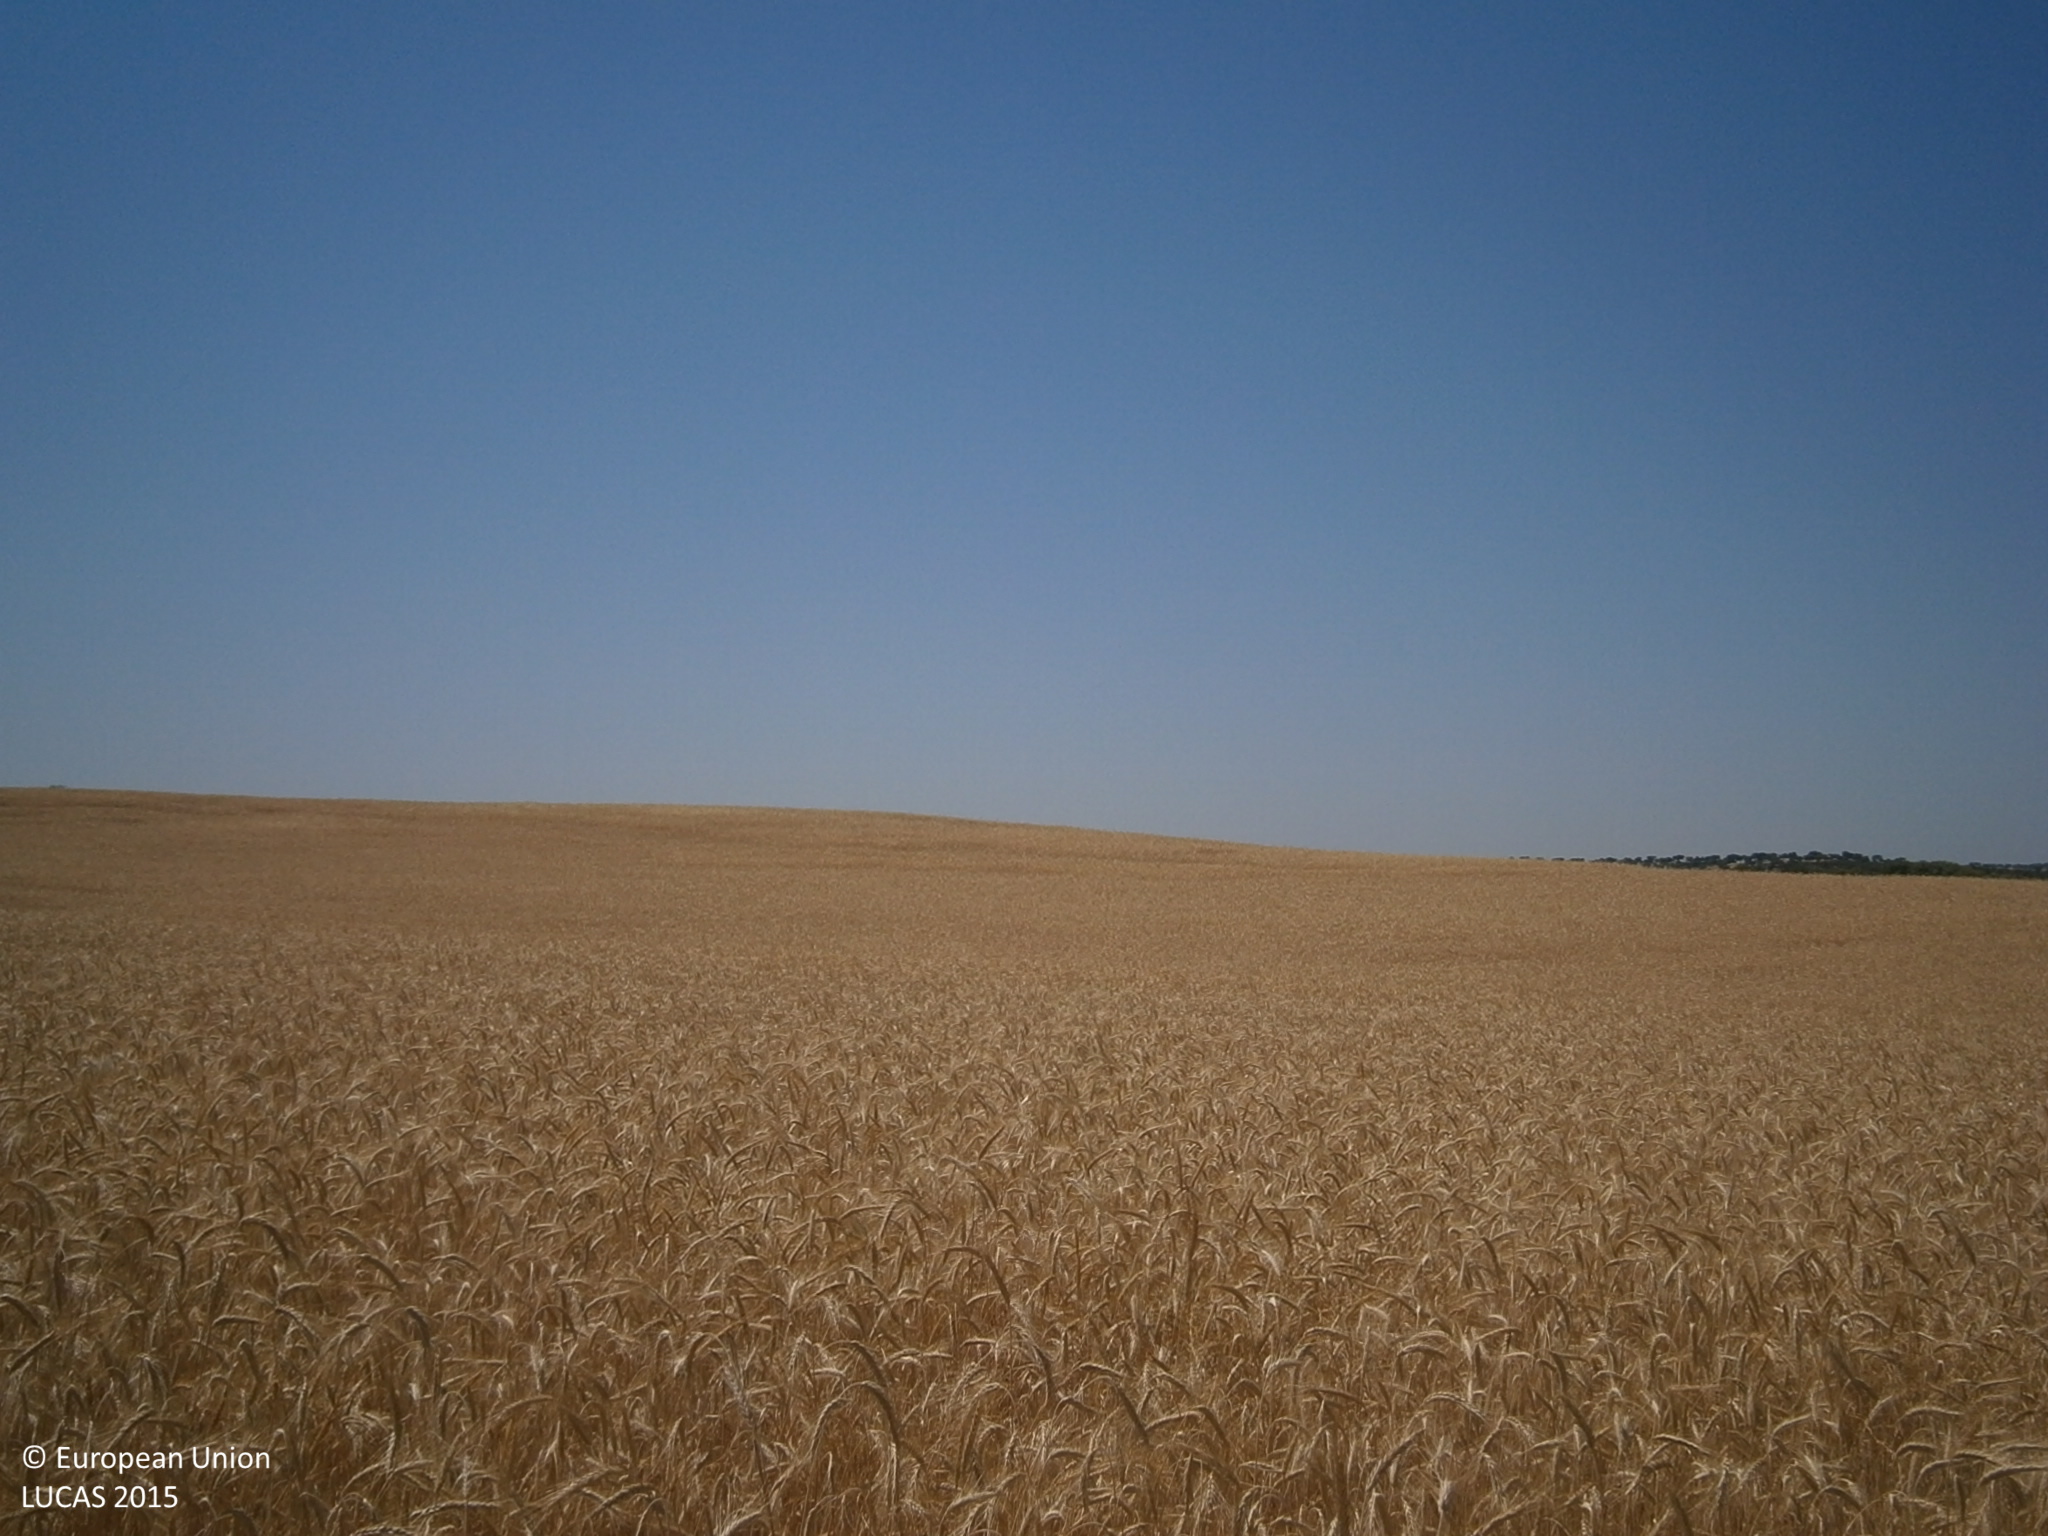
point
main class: Cropland
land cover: Durum wheat
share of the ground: > 75 %
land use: Agriculture (excluding fallow land and kitchen gardens)
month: June
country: ES
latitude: 38.6892
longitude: -6.2037
